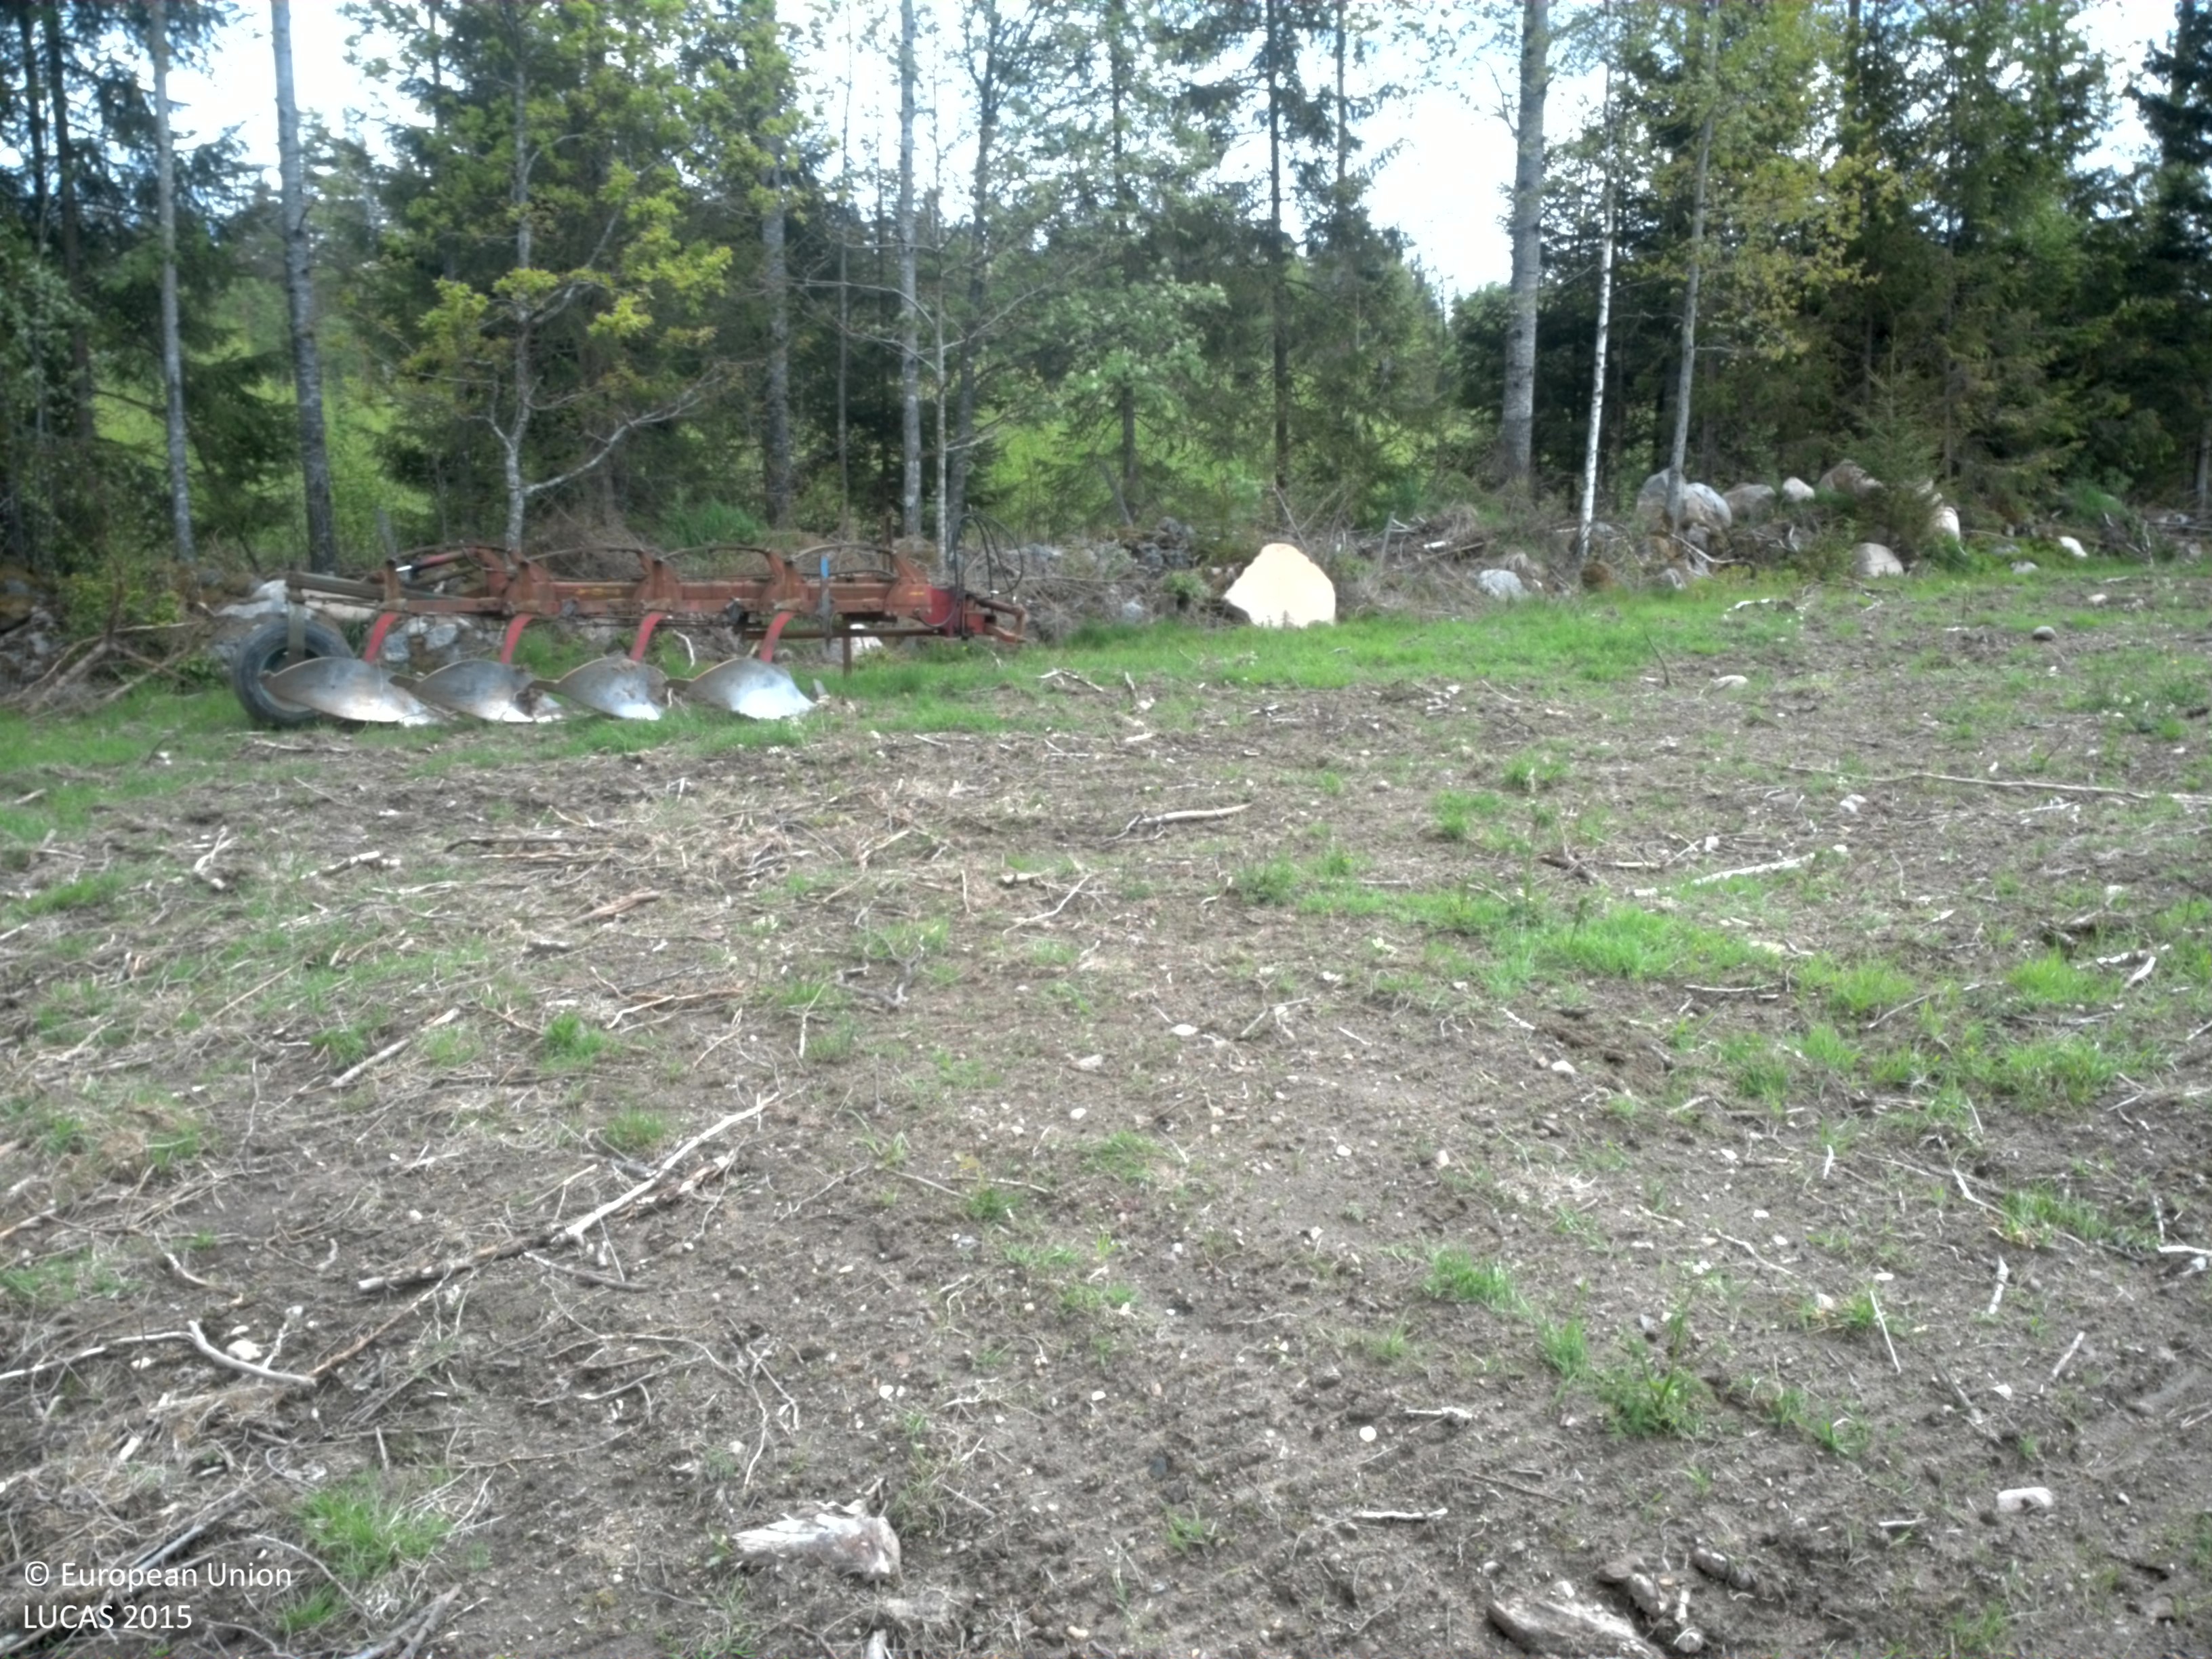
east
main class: Cropland
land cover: Other leguminous and mixtures for fodder
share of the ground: 25 - 50 %
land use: Agriculture (excluding fallow land and kitchen gardens)
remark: Tilled/Sowed
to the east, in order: Other leguminous and mixtures for fodder; Dry stone walls; Lines of trees; Broadleaved woodland; Ditches and canals; Spruce dominated coniferous woodland
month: May
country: SE
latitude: 56.5322
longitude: 15.2176
